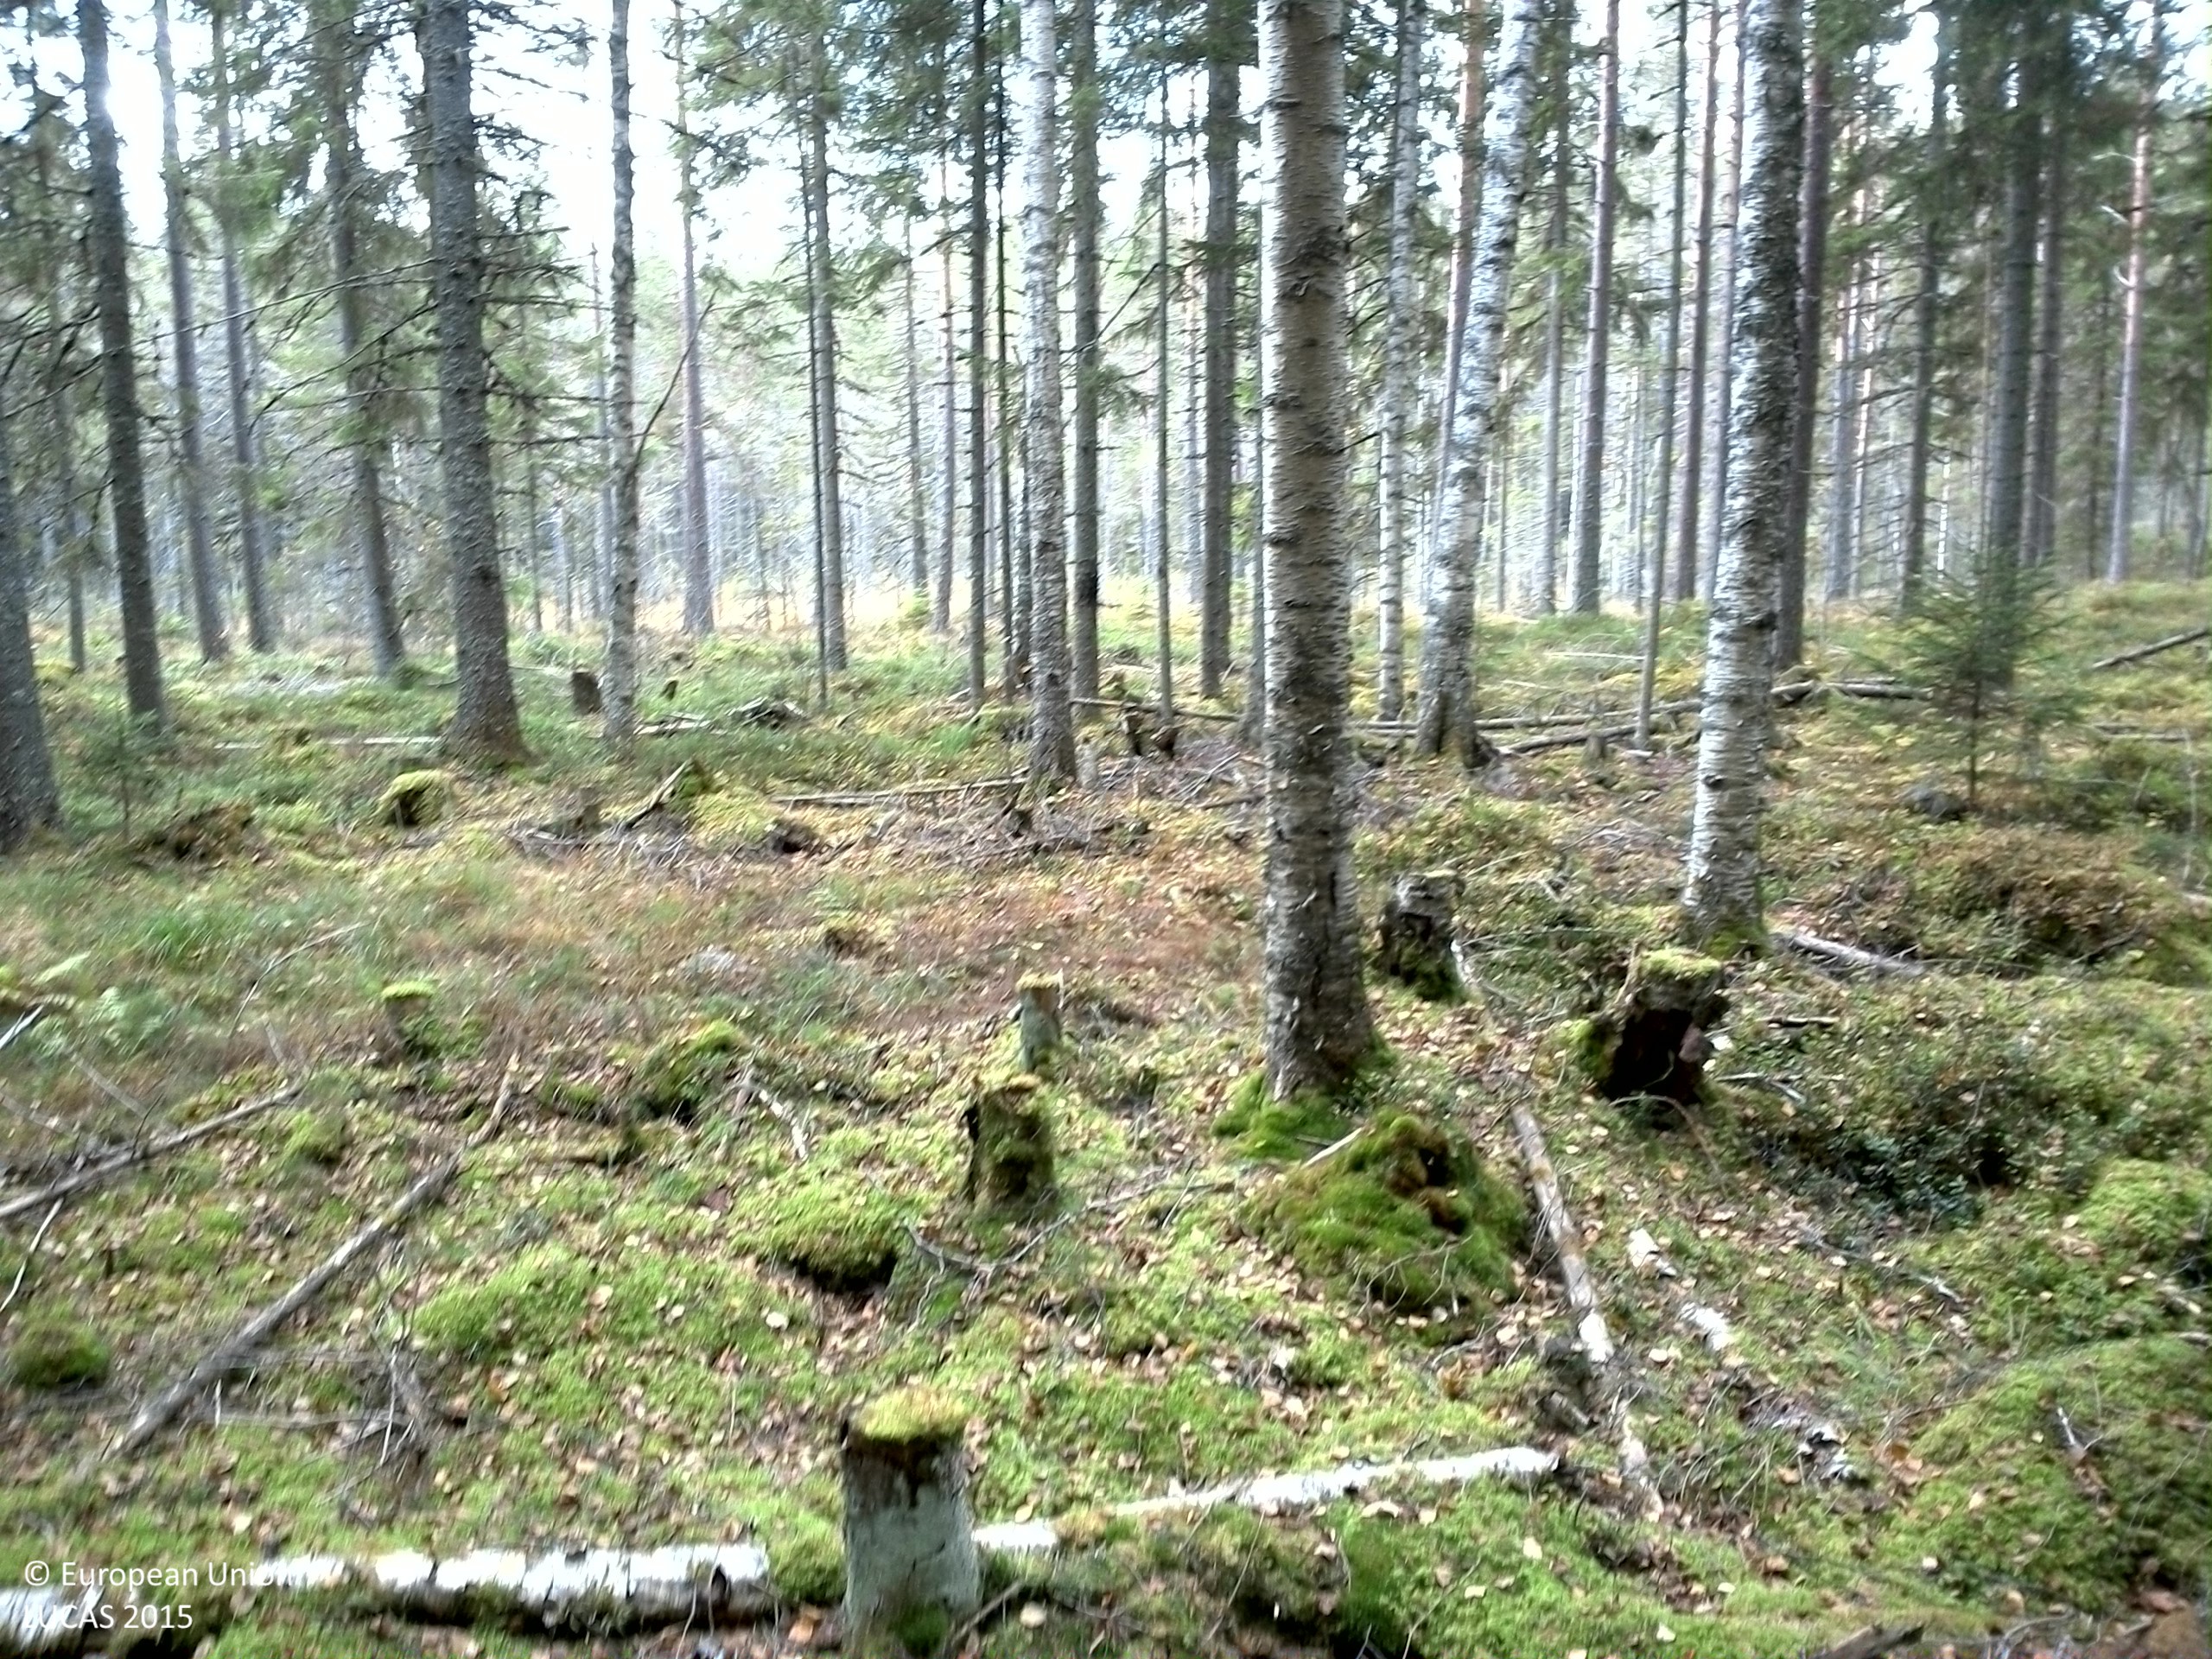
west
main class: Woodland
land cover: Spruce dominated mixed woodland
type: boreal forest
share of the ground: > 75 %
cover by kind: coniferous forest trees 55 %, broadleaved forest trees 20 %, lichens and mosses 15 %, shrubs 10 %
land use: Forestry
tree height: > 5 m
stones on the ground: < 10 %
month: October
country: SE
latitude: 61.2055
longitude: 14.6200
